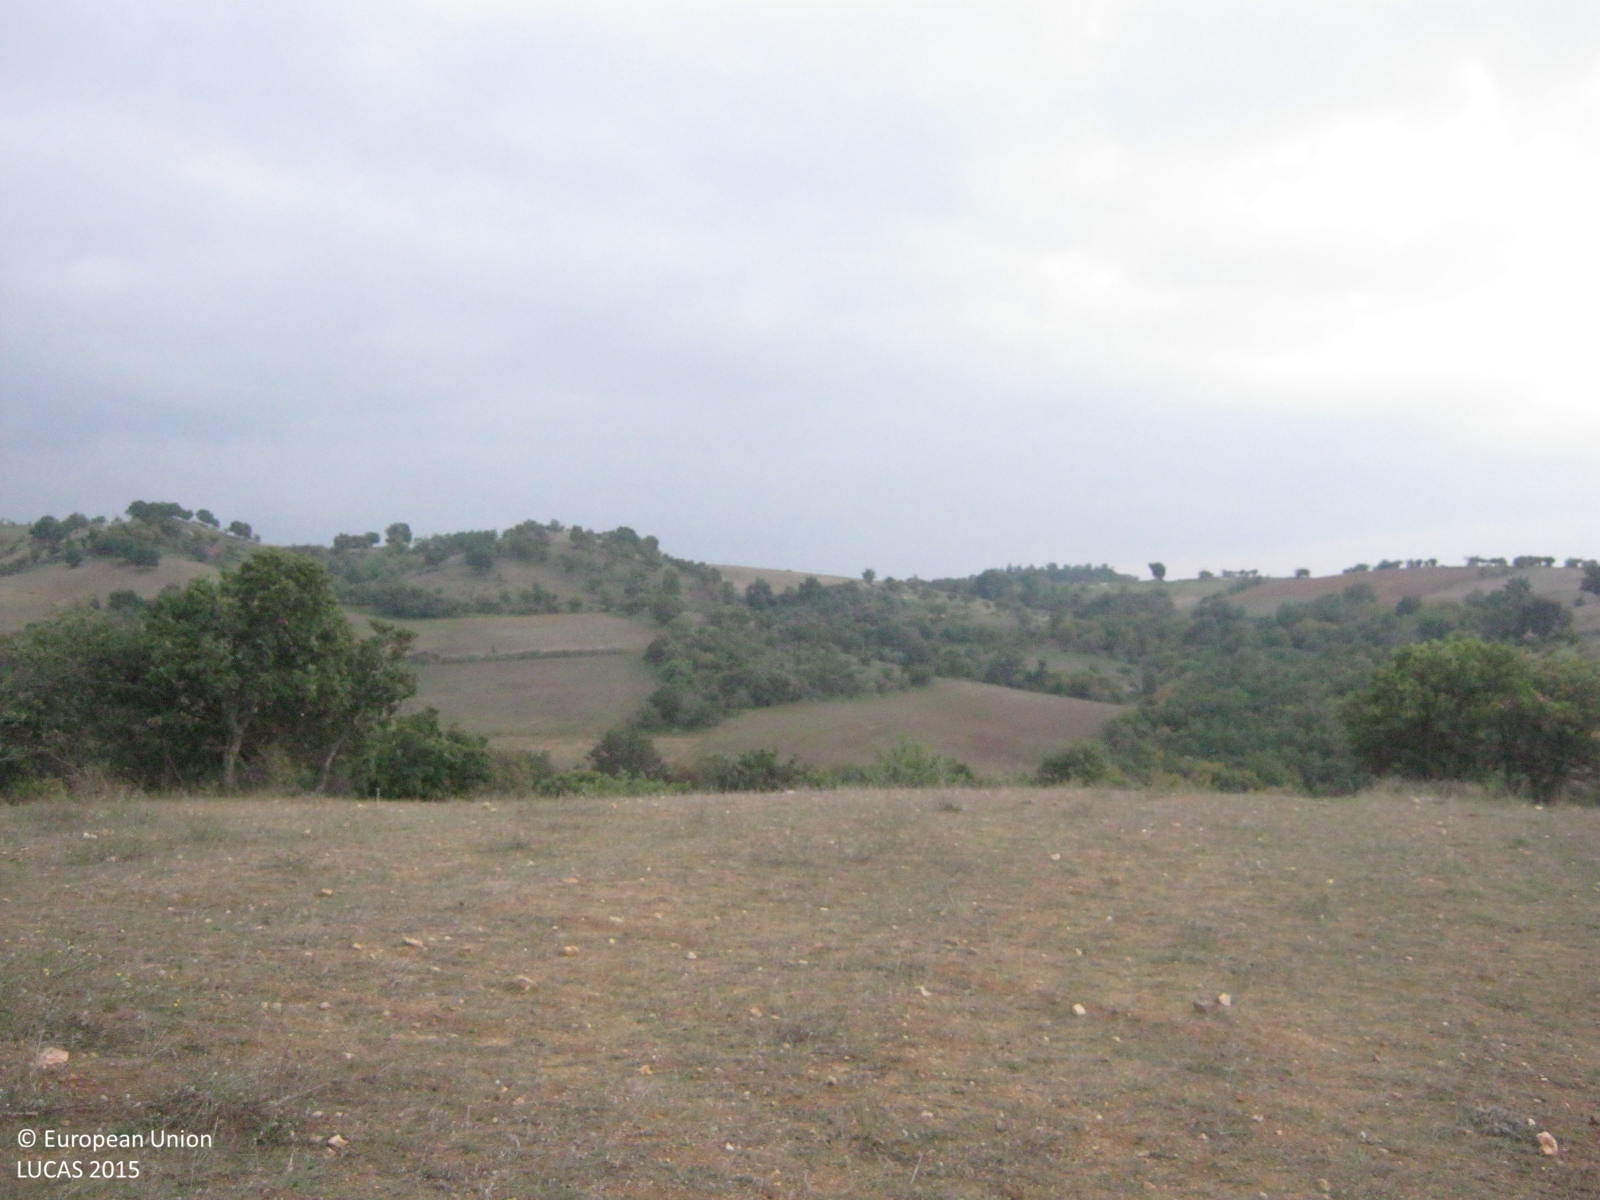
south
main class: Grassland
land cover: Grassland with sparse tree/shrub cover
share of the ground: > 75 %
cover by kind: herbaceous plants 75 %, unconsolidated bare surface 20 %, broadleaved forest trees 5 %
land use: Agriculture (excluding fallow land and kitchen gardens)
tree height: < 5 m
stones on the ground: 25 - 50 %
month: October
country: GR
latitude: 41.0249
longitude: 23.0114
